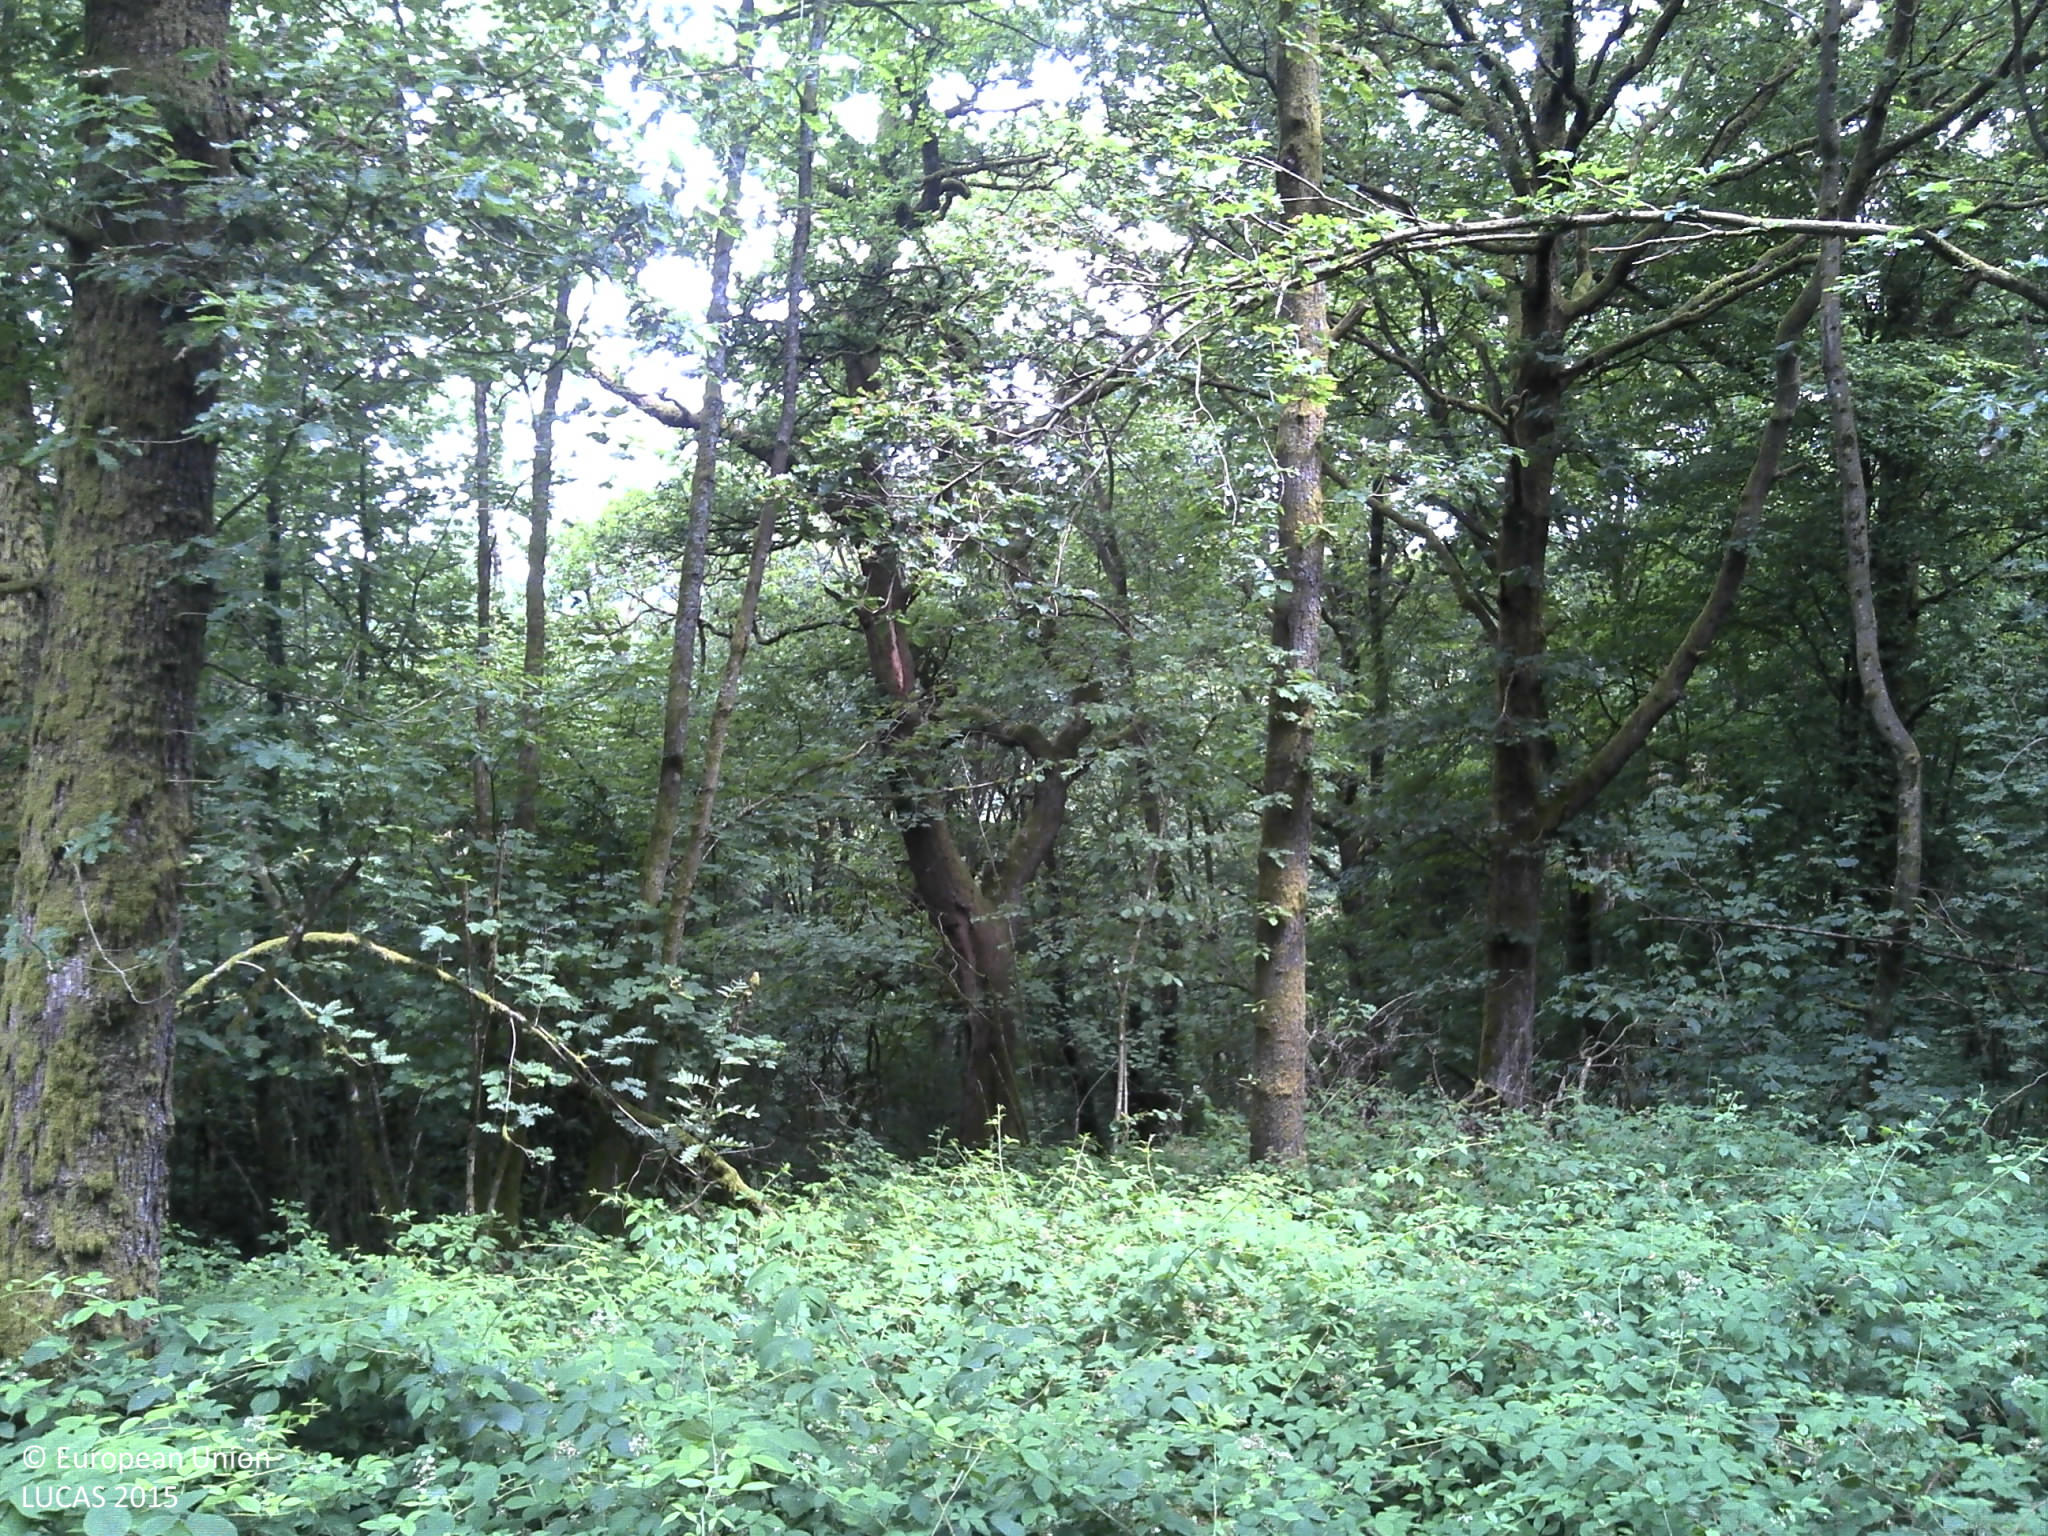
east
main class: Woodland
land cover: Broadleaved woodland
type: acidophilous oak and oak-birch forest
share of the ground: > 75 %
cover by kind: broadleaved forest trees 70 %, herbaceous plants 30 %
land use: Forestry
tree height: > 5 m
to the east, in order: Broadleaved woodland; Spruce dominated coniferous woodland; Broadleaved woodland; Spontaneously vegetated surfaces; Electric lines; Spontaneously vegetated surfaces
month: July
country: FR
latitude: 49.8460
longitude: 4.7261
